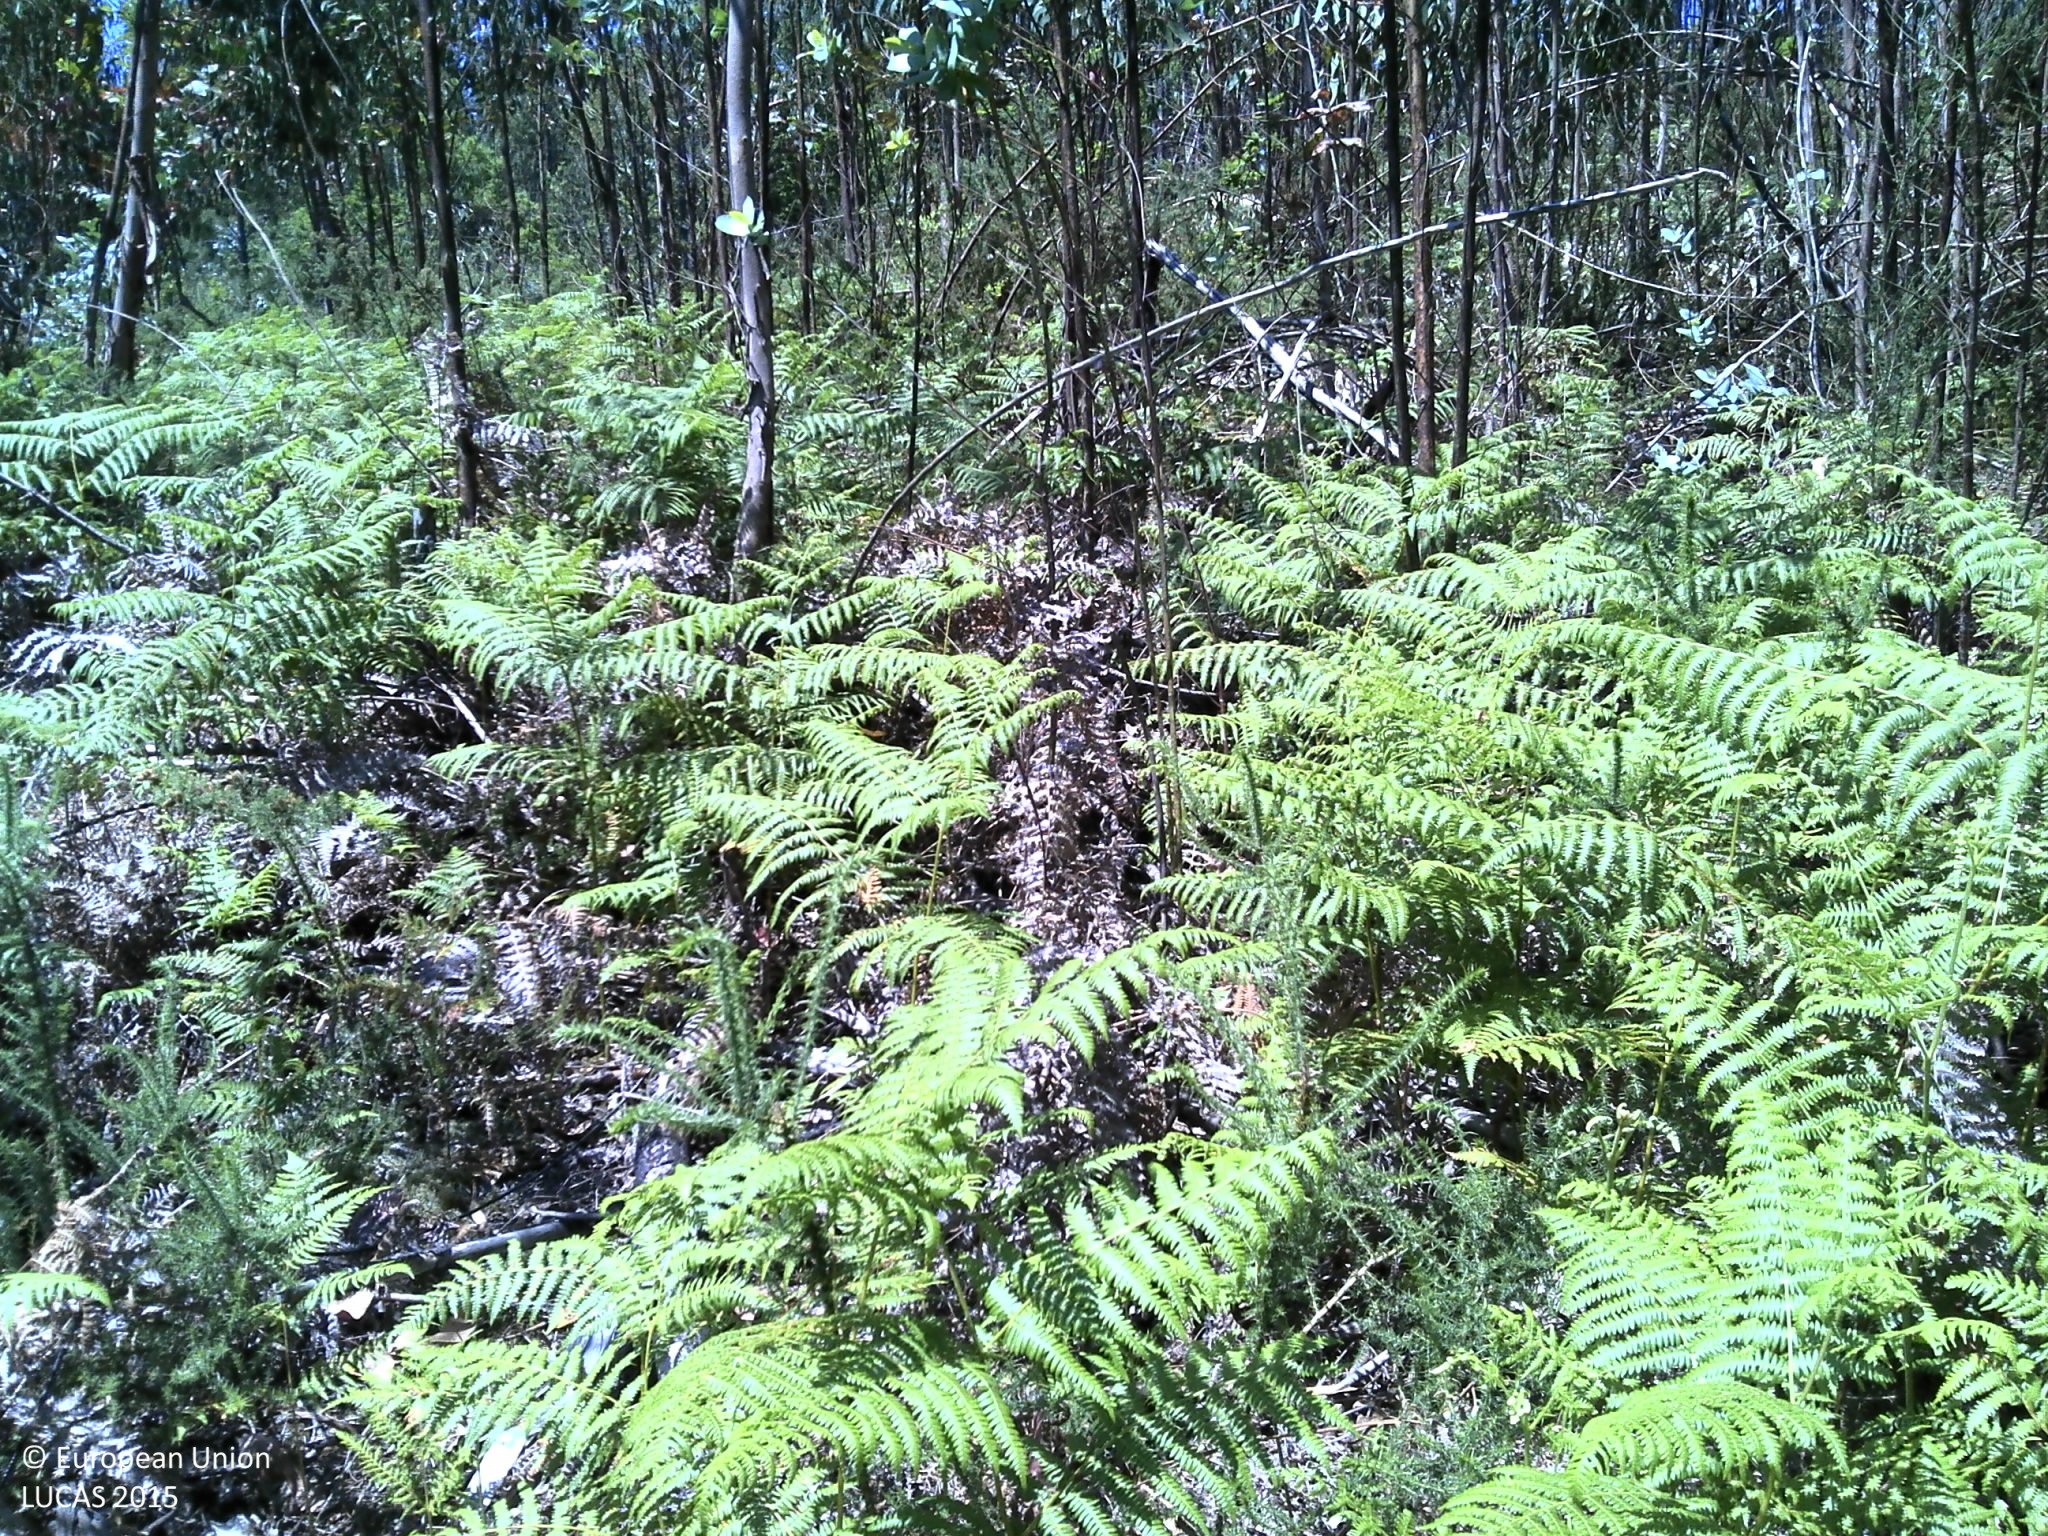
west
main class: Woodland
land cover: Broadleaved woodland
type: exotic forest
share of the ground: 25 - 50 %
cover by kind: broadleaved forest trees 50 %, shrubs 35 %, unconsolidated bare surface 10 %, herbaceous plants 5 %
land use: Forestry
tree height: > 5 m
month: May
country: PT
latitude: 41.6843
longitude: -8.6270
